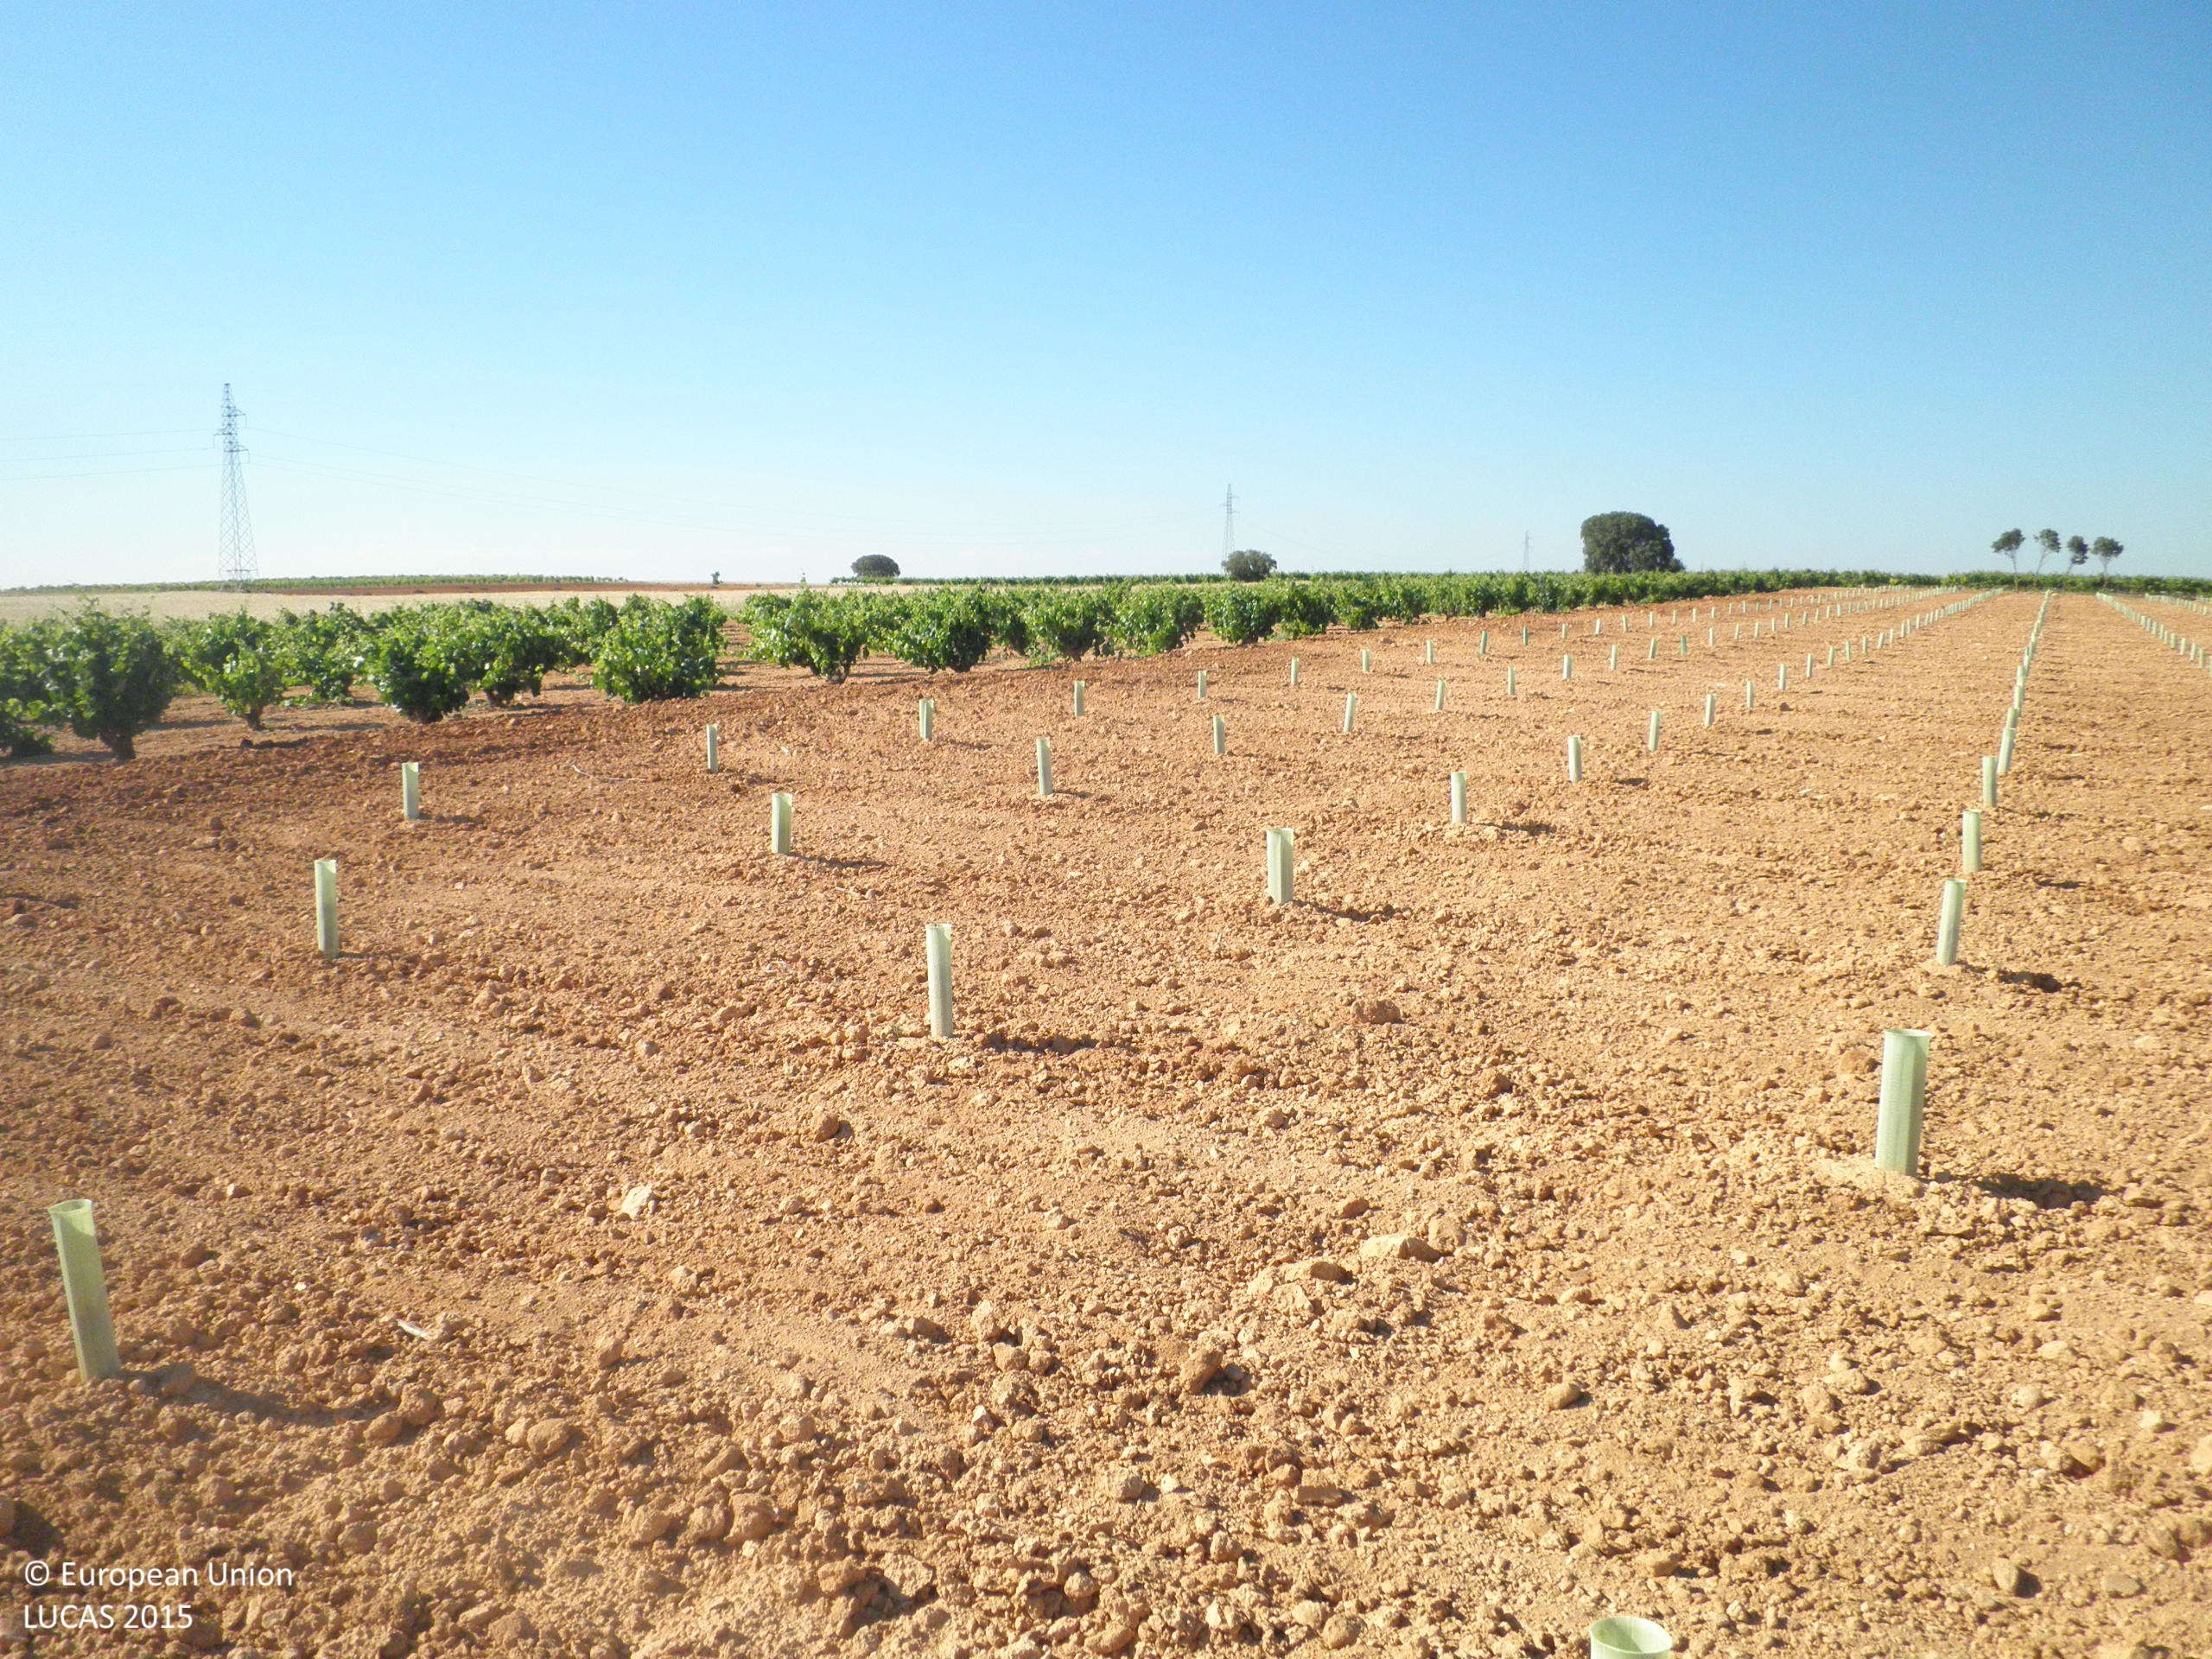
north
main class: Cropland
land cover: Vineyards
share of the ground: < 10 %
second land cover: Other bare soil
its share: > 75 %
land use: Agriculture (excluding fallow land and kitchen gardens)
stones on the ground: < 10 %
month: June
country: ES
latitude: 39.4033
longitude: -1.6751
